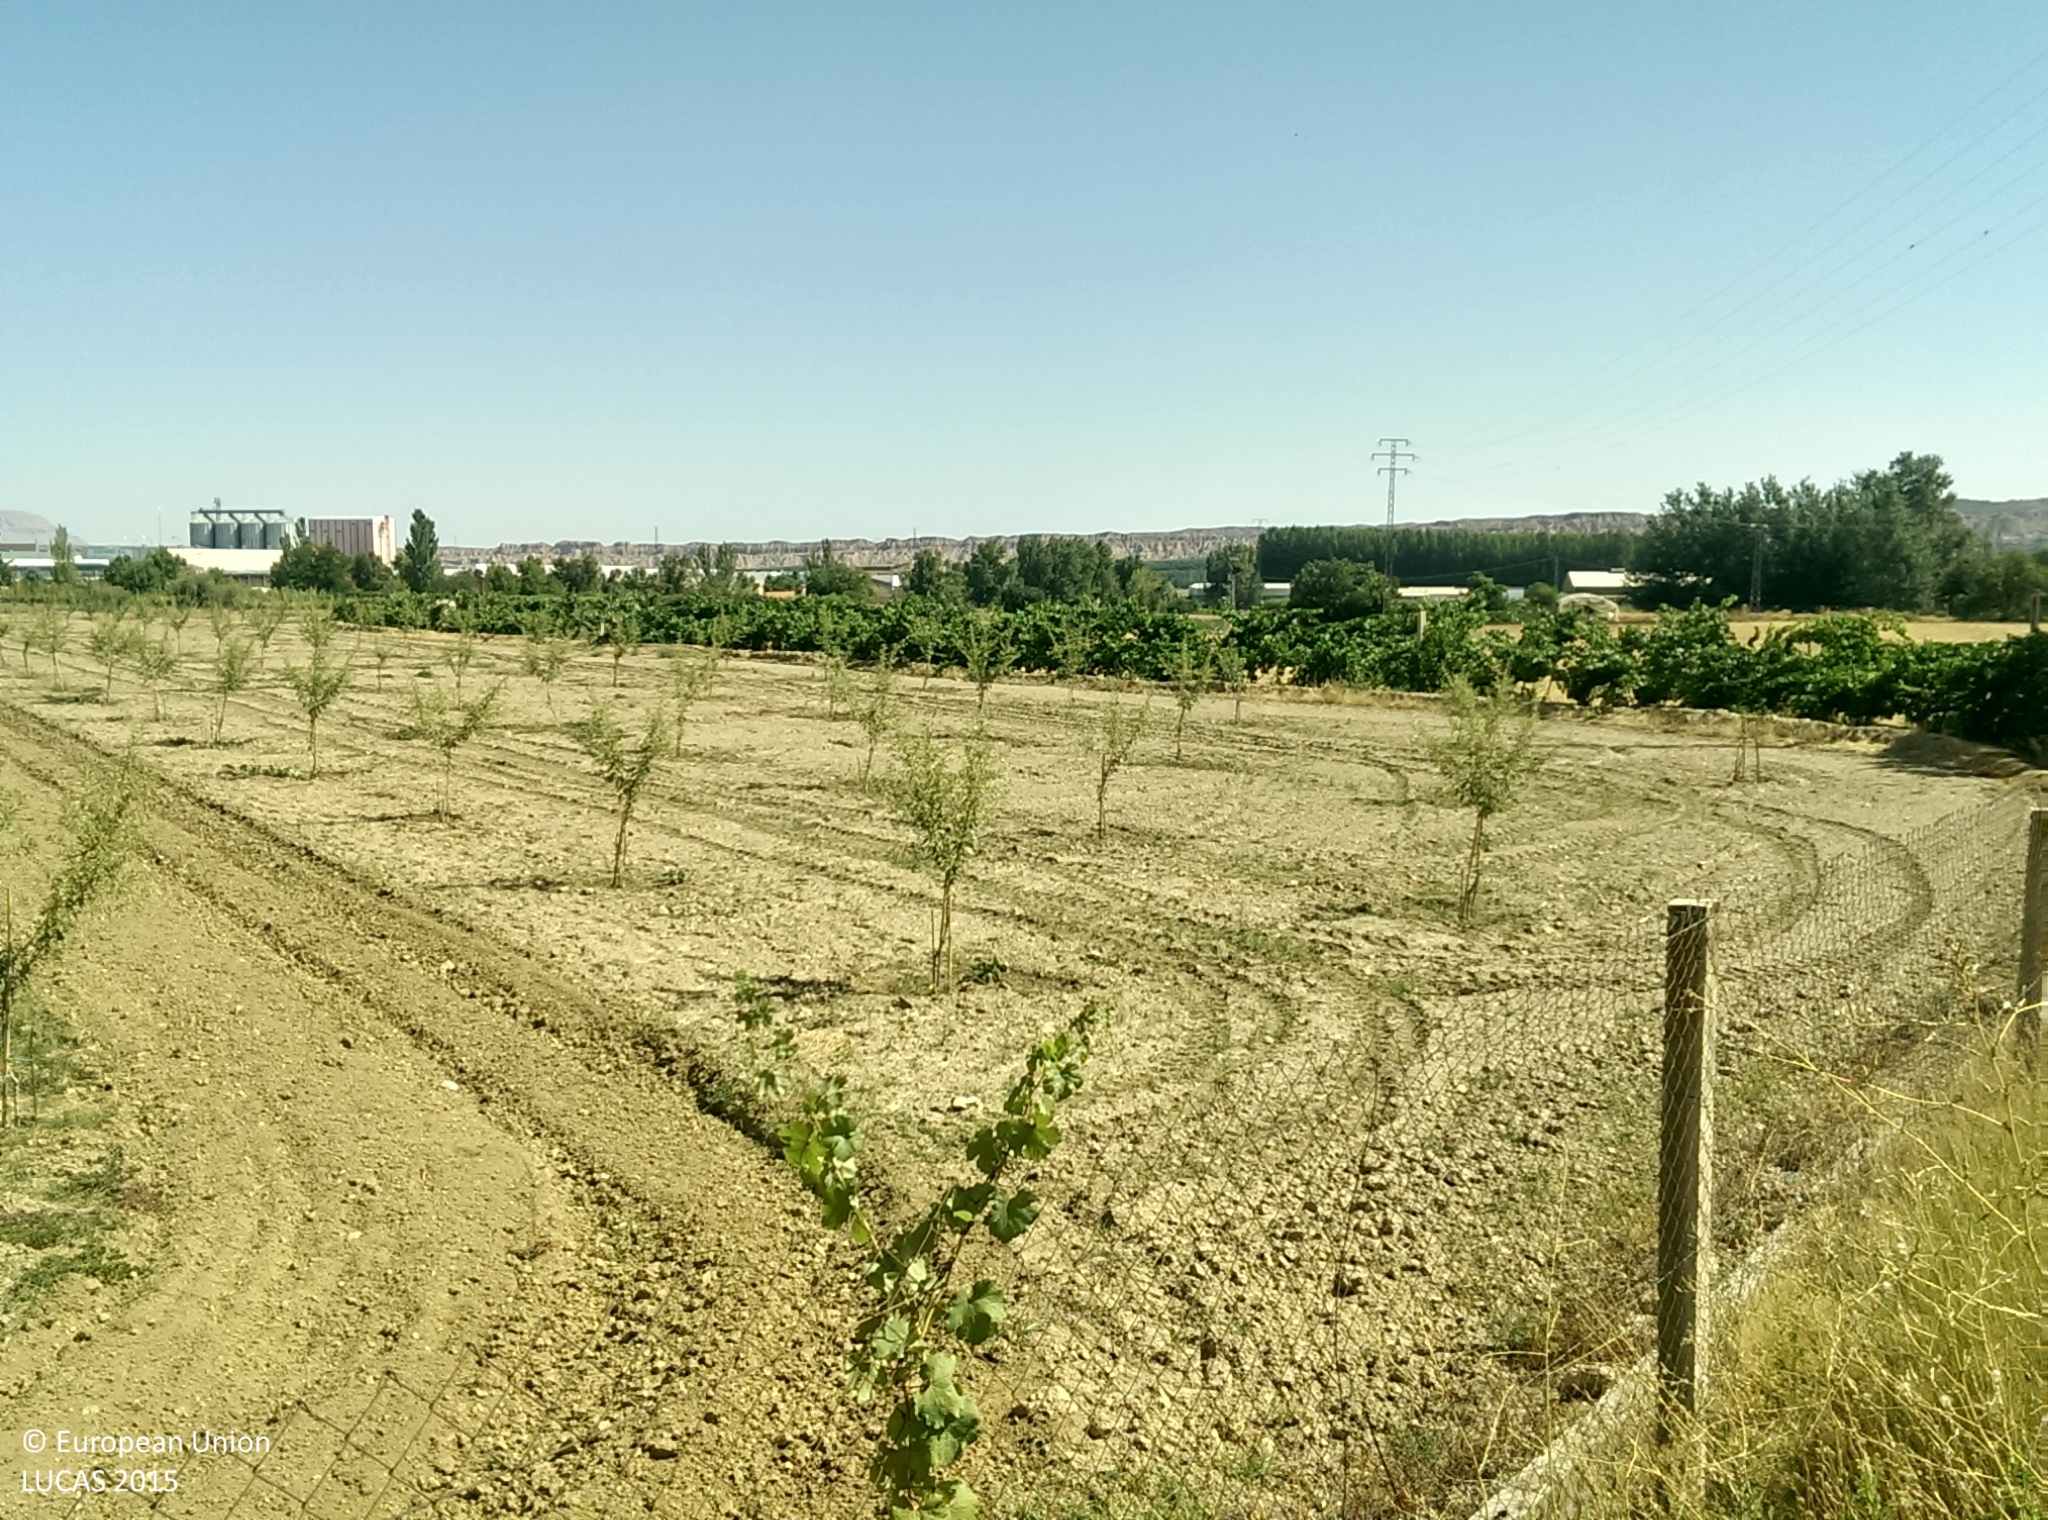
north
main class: Cropland
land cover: Nuts trees
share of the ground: 10 - 25 %
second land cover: Other bare soil
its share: > 75 %
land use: Agriculture (excluding fallow land and kitchen gardens)
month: July
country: ES
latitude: 37.3066
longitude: -3.1540
